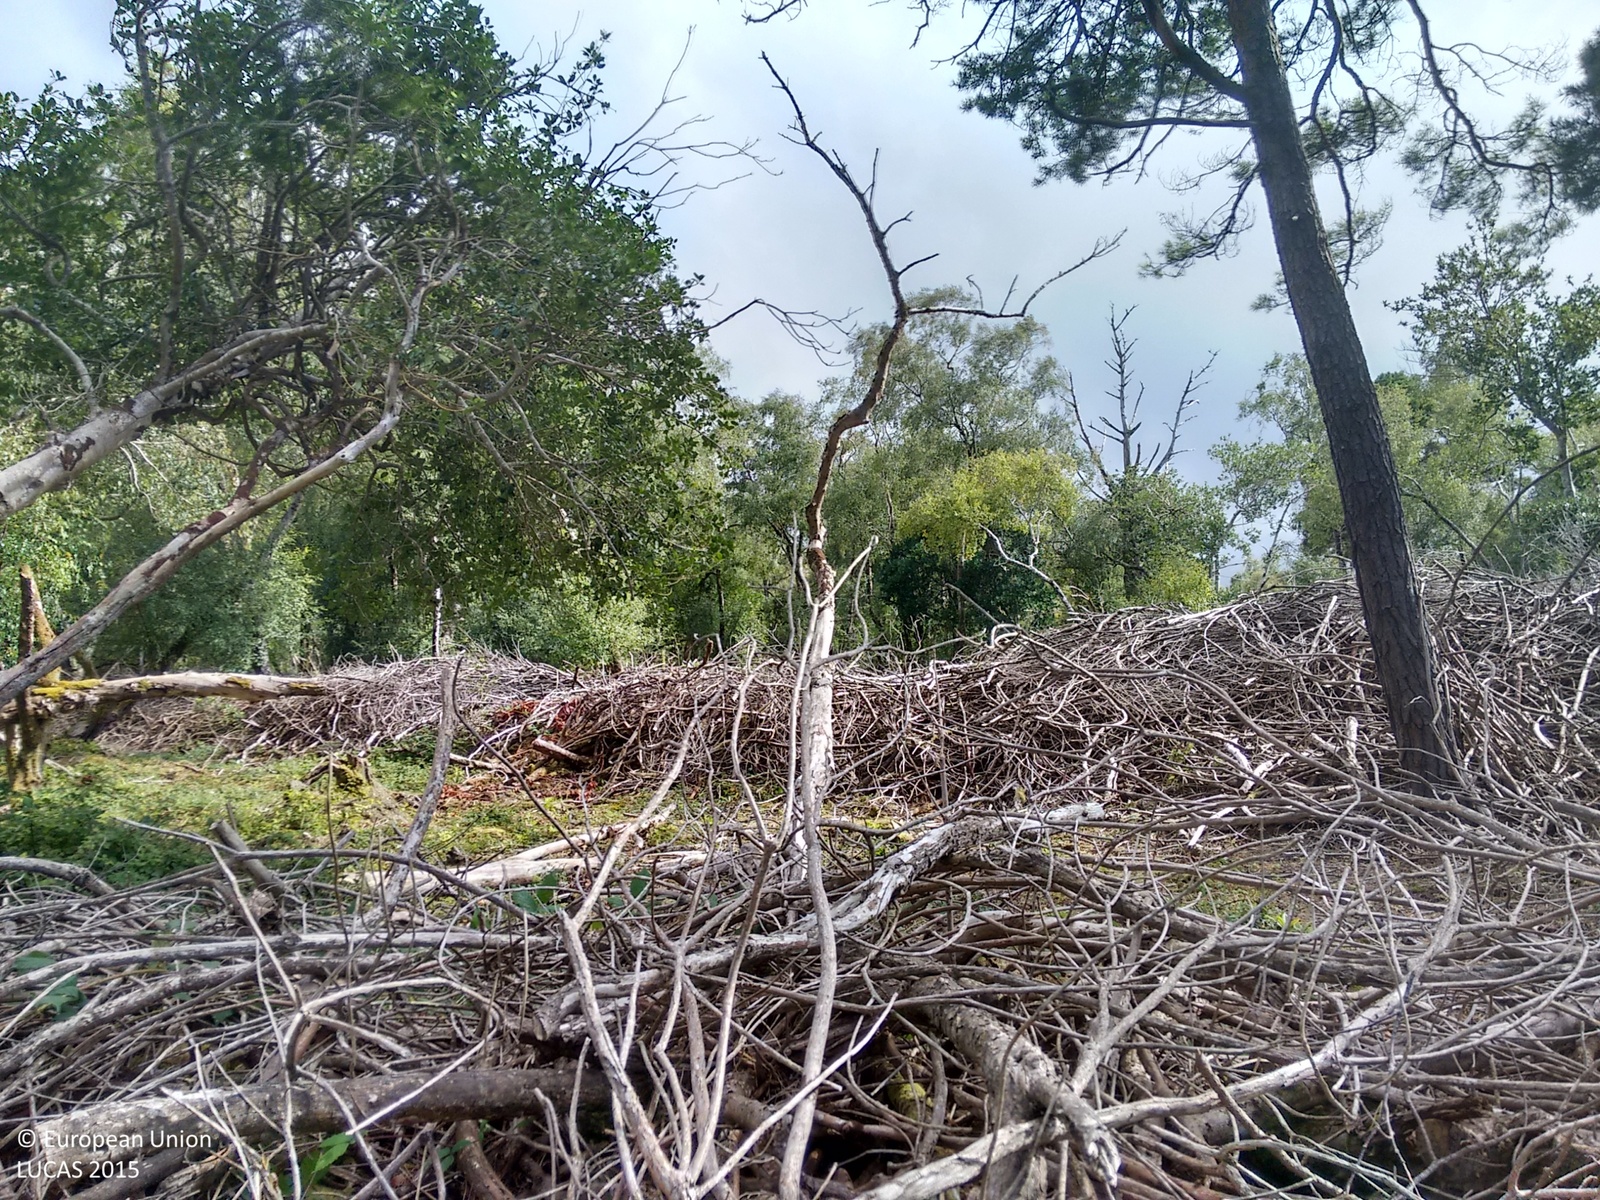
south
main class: Woodland
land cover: Pine dominated mixed woodland
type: exotic forest
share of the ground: > 75 %
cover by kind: coniferous forest trees 40 %, broadleaved forest trees 20 %, unconsolidated bare surface 15 %, herbaceous plants 10 %
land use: Amenities, museums, leisure
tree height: > 5 m
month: August
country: IE
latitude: 52.0478
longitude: -9.5252
